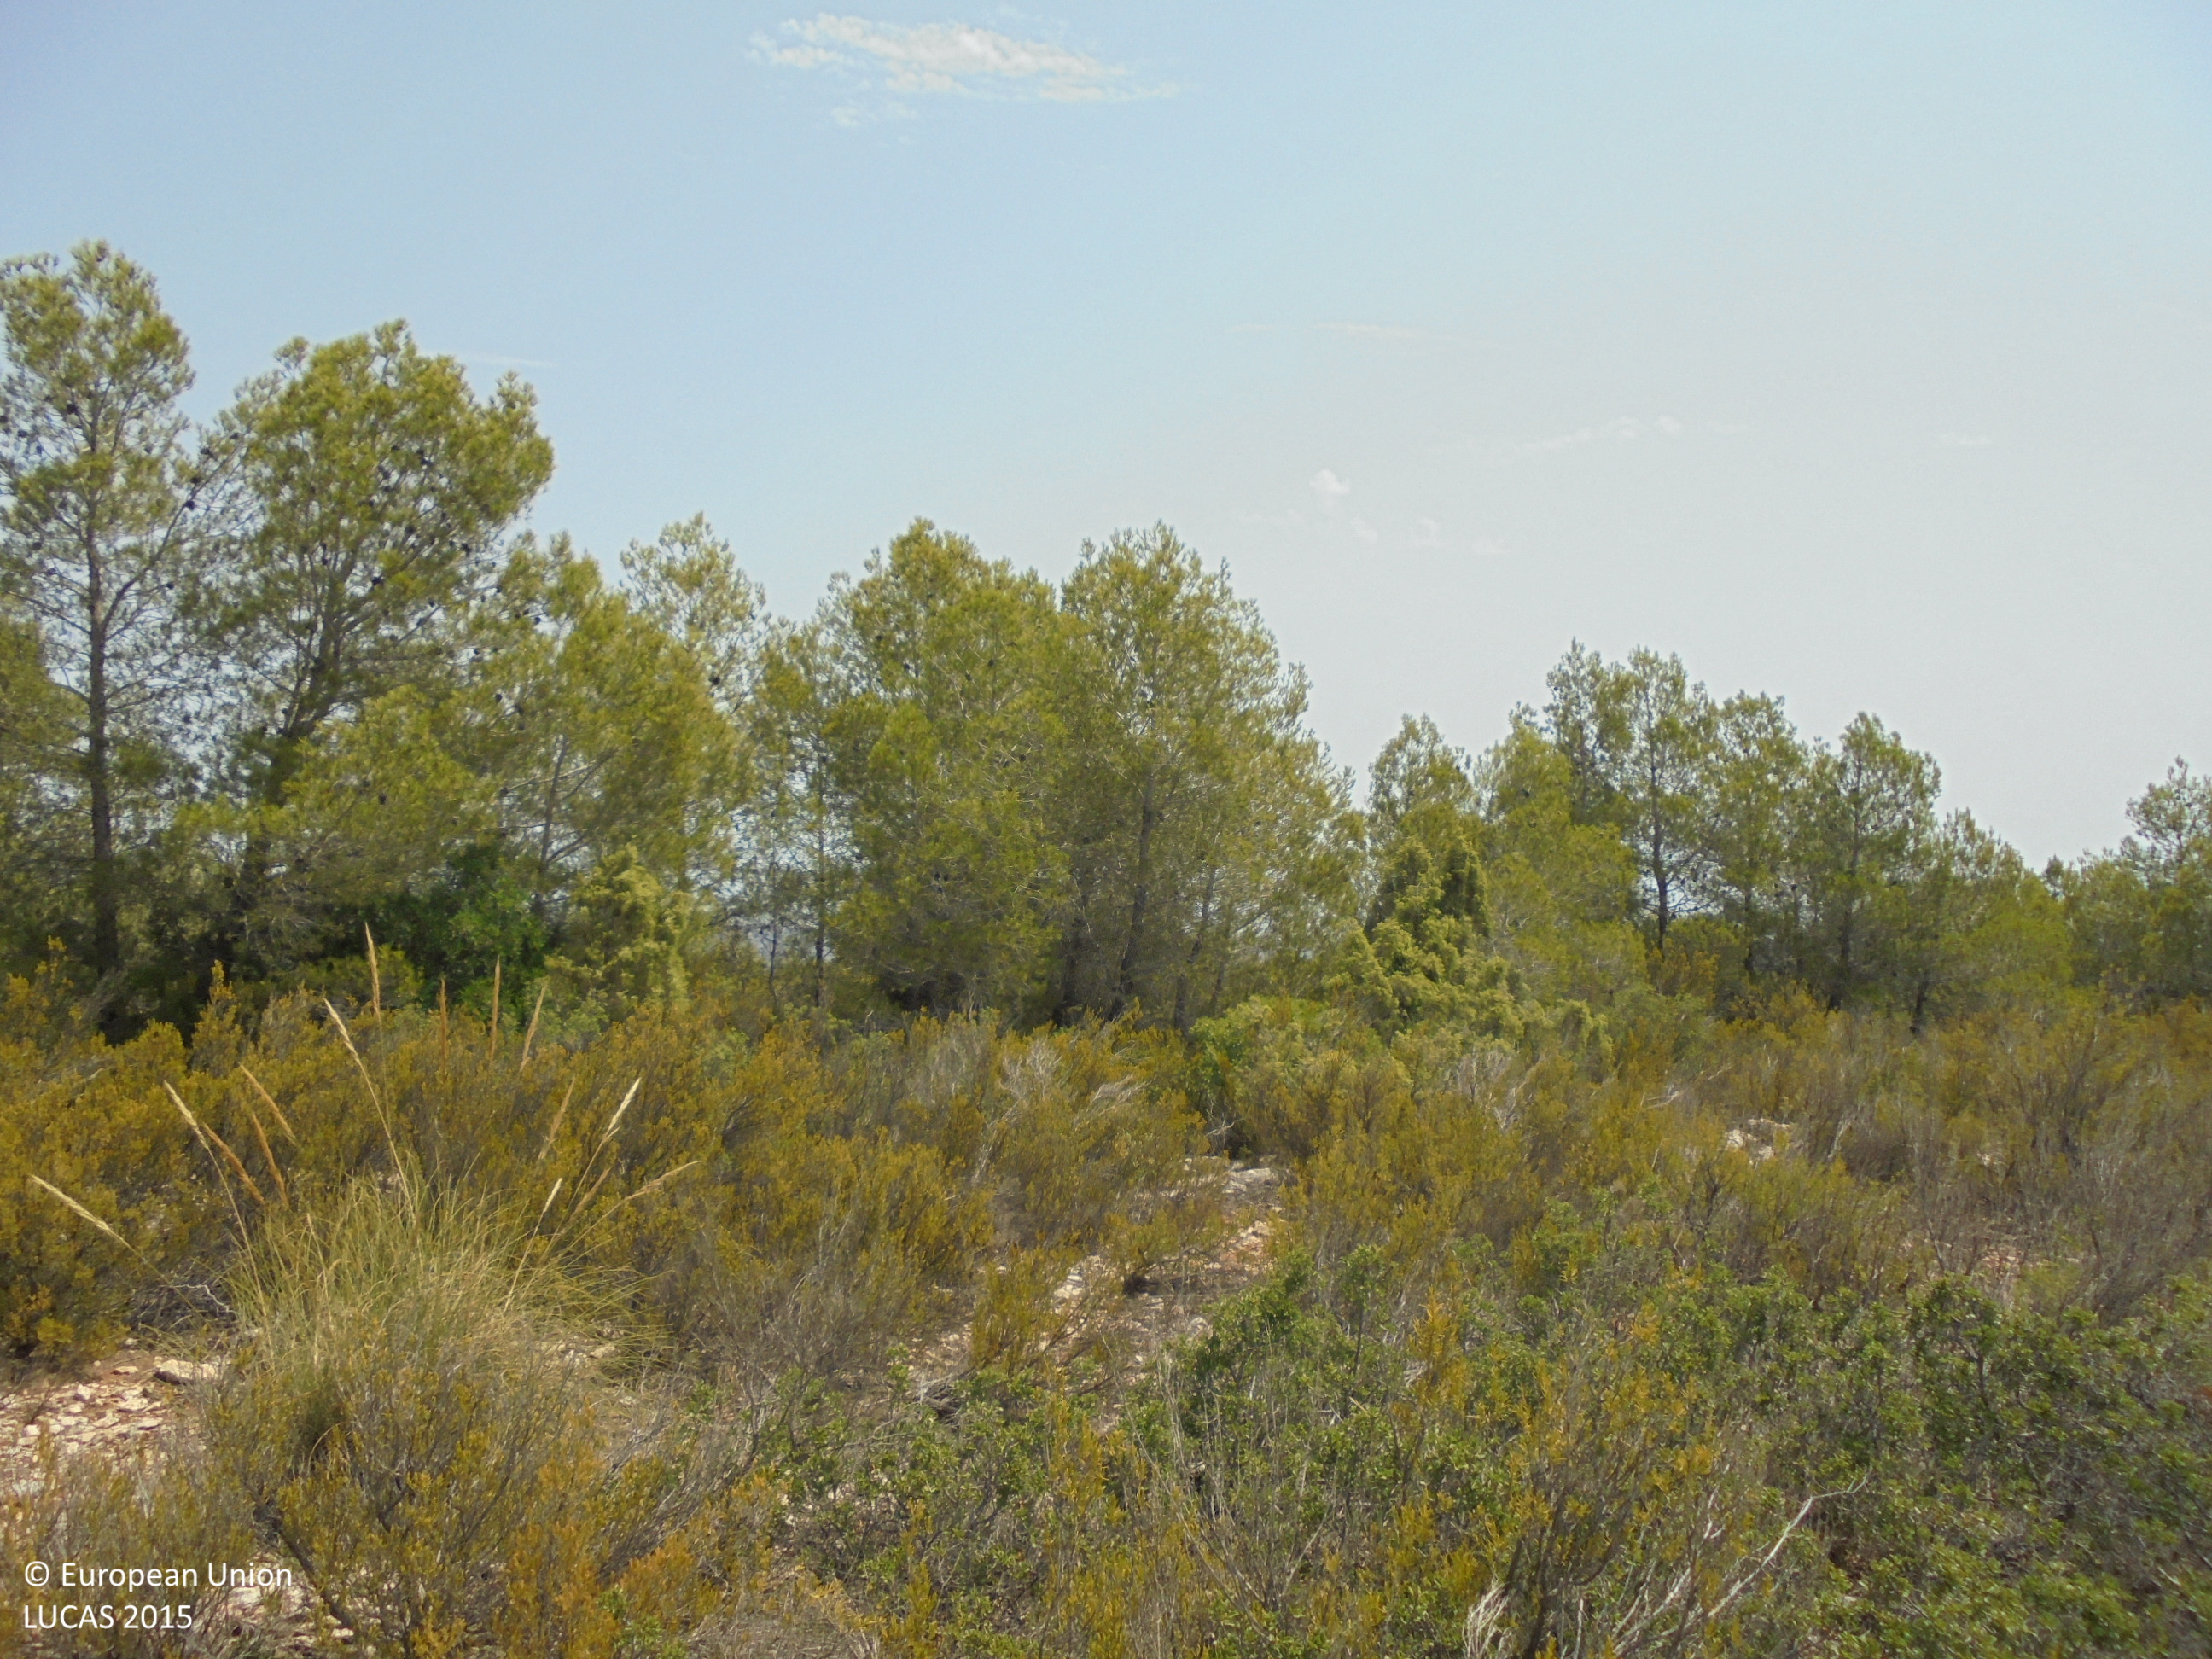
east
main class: Shrubland
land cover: Shrubland with sparse tree cover
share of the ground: > 75 %
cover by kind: shrubs 80 %, unconsolidated bare surface 15 %, coniferous forest trees 5 %
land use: Semi-natural and natural areas not in use
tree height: < 5 m
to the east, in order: Shrubland with sparse tree cover; Pine dominated coniferous woodland; Shrubland with sparse tree cover
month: August
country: ES
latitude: 39.1720
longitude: -0.8418
